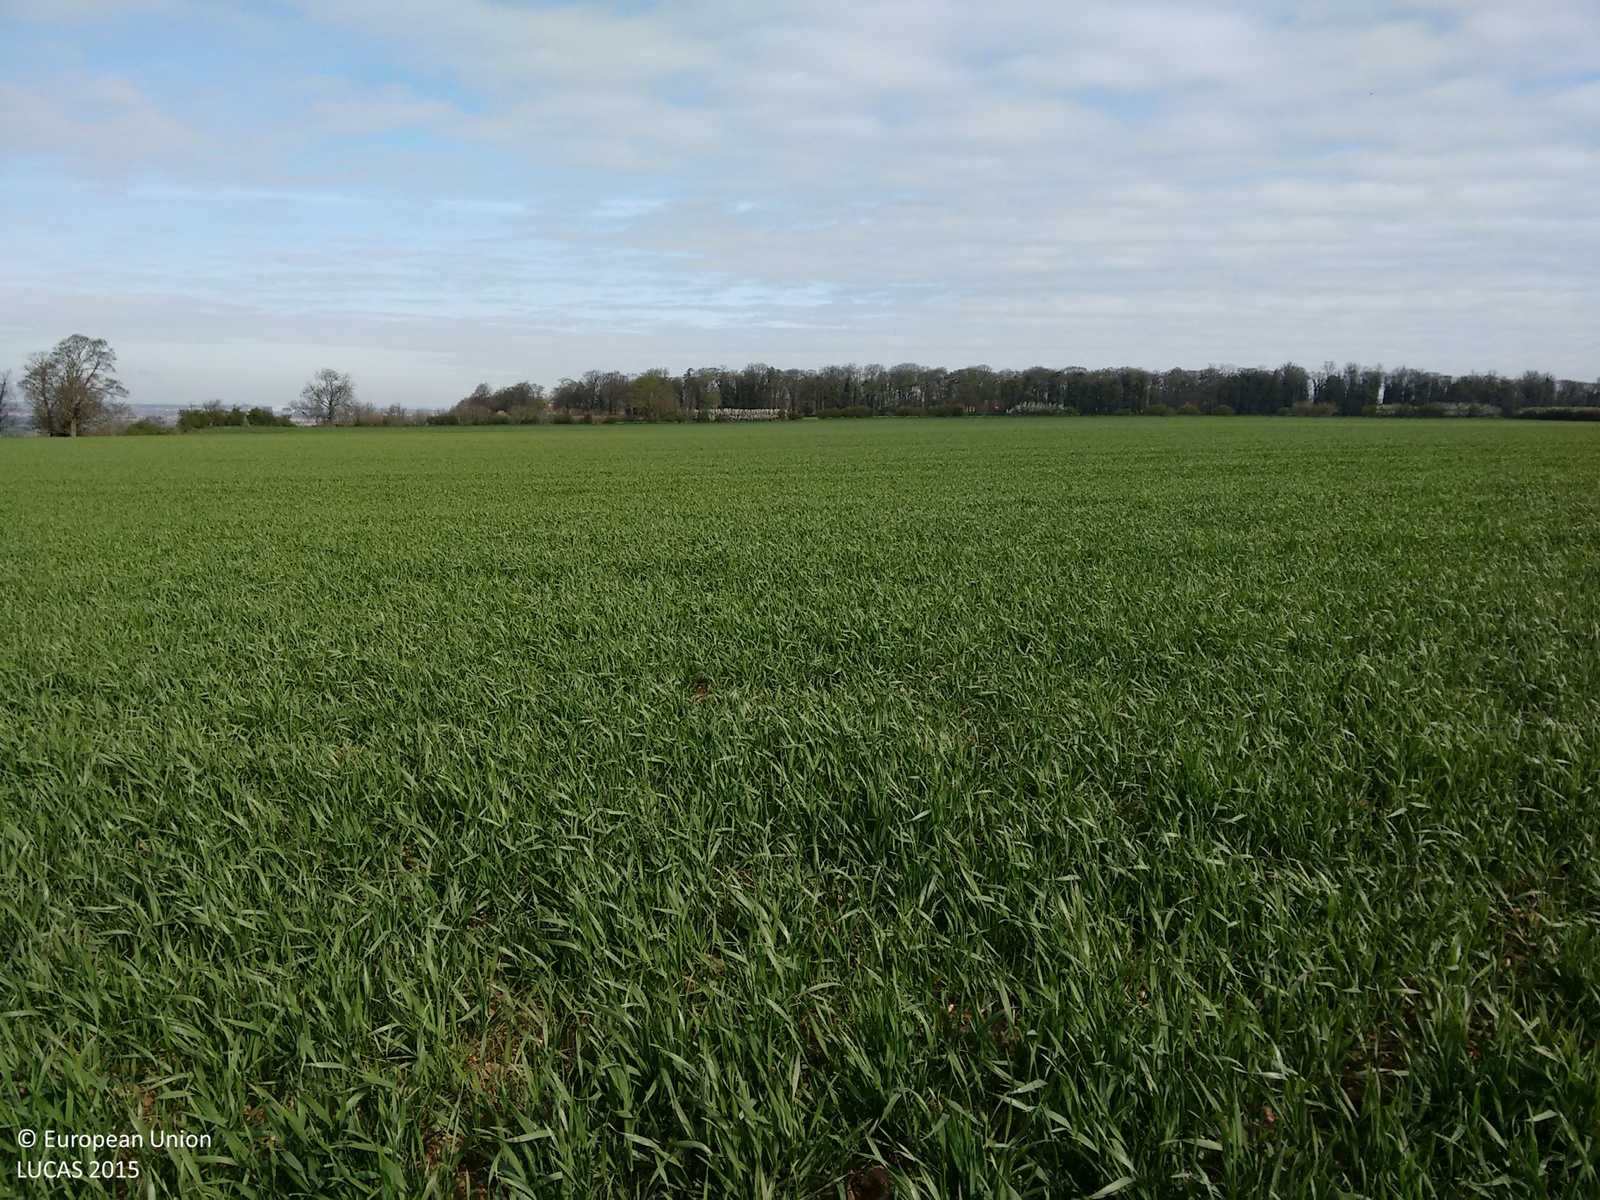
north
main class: Cropland
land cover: Common wheat
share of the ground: > 75 %
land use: Agriculture (excluding fallow land and kitchen gardens)
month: April
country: GB
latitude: 53.1395
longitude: -0.5472
